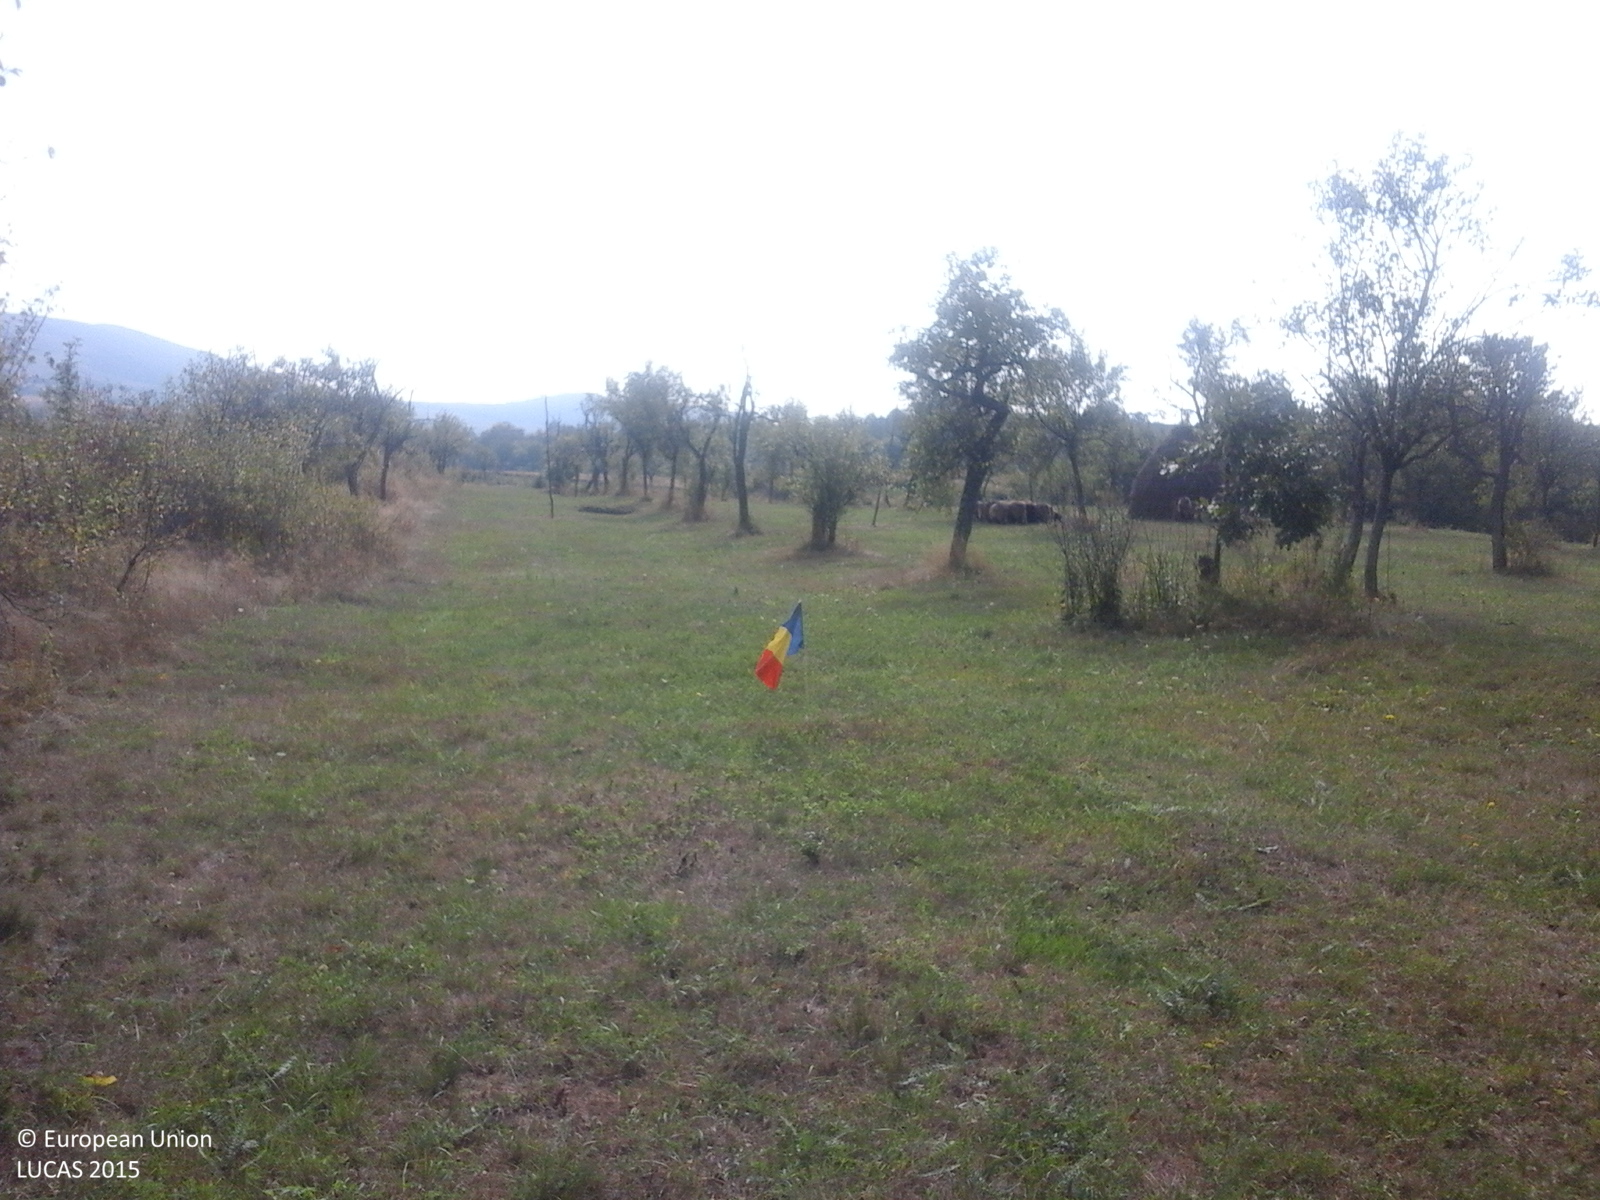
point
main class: Cropland
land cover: Other fruit trees and berries
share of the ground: 50 - 75 %
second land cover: Grassland without tree/shrub cover
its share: > 75 %
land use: Agriculture (excluding fallow land and kitchen gardens)
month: September
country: RO
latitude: 45.0532
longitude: 22.3184
